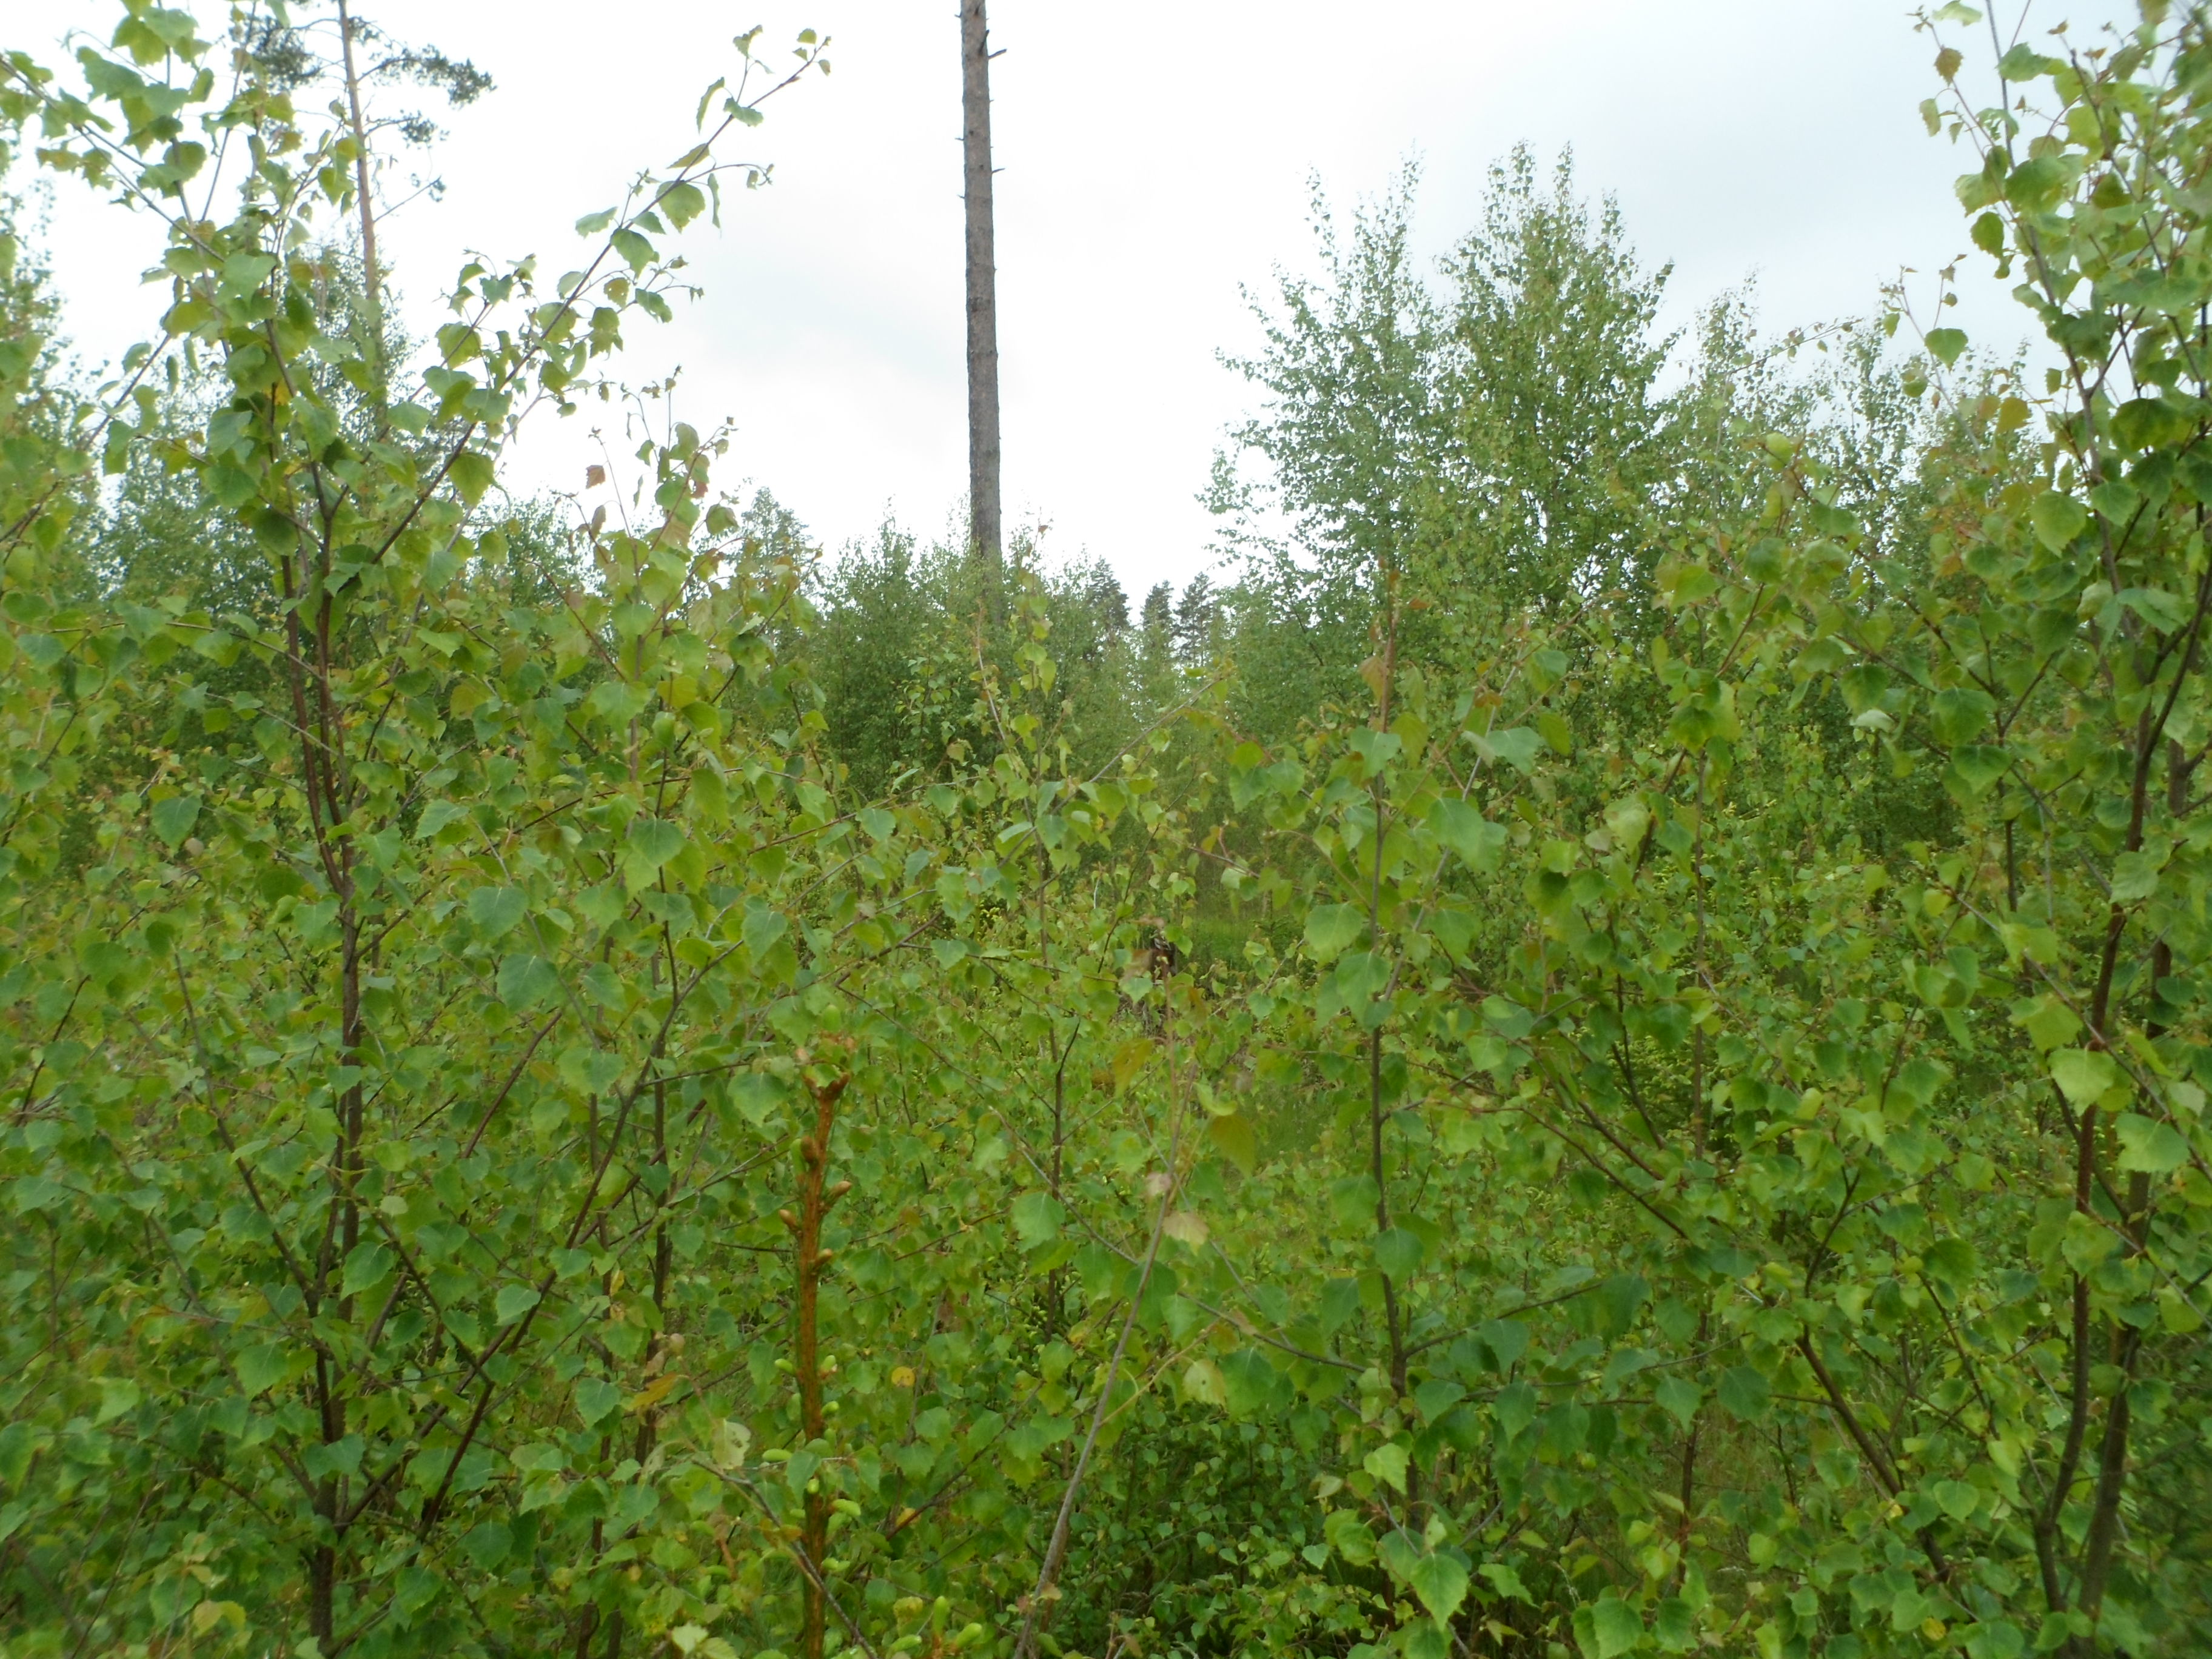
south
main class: Woodland
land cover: Broadleaved woodland
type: boreal forest
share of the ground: > 75 %
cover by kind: broadleaved forest trees 75 %, herbaceous plants 10 %, coniferous forest trees 5 %, shrubs 5 %, lichens and mosses 5 %
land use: Forestry
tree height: < 5 m
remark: Clear cut
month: June
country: SE
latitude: 56.9154
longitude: 14.6124
